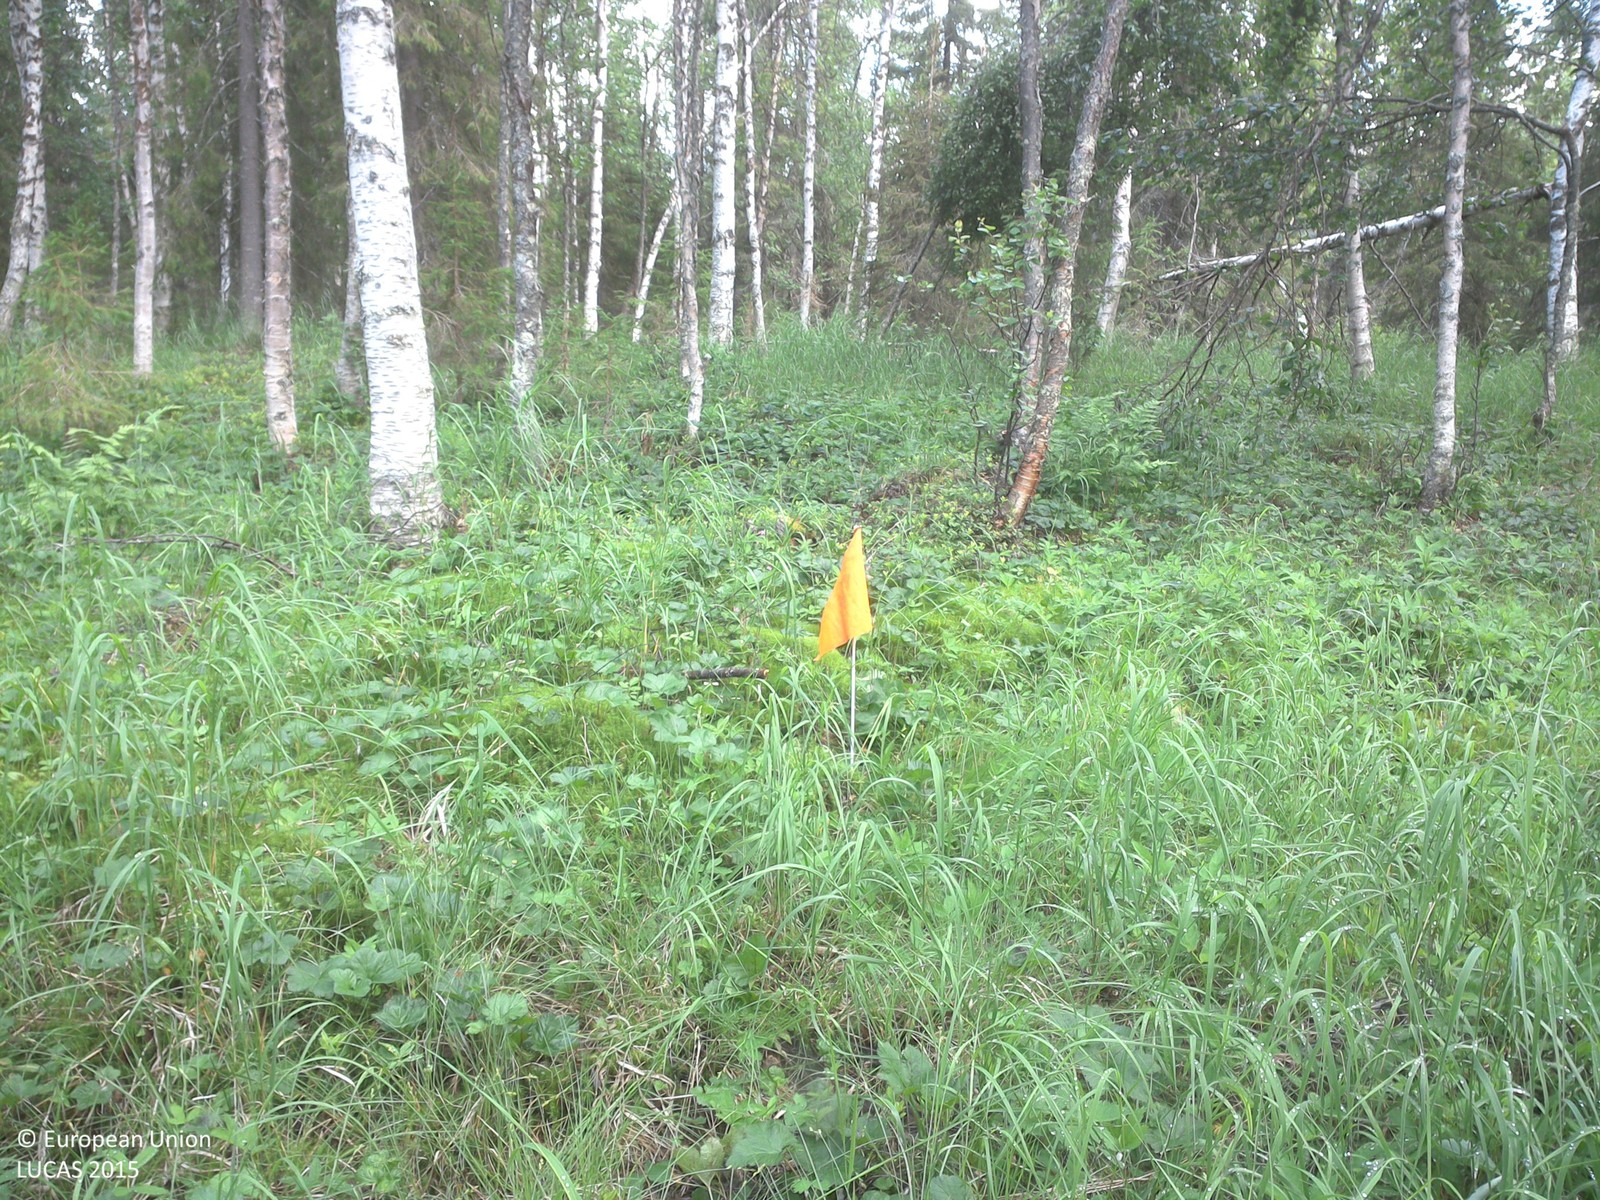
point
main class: Woodland
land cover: Other mixed woodland
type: boreal forest
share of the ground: 25 - 50 %
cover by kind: broadleaved forest trees 30 %, herbaceous plants 30 %, shrubs 15 %, lichens and mosses 15 %, coniferous forest trees 10 %
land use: Forestry
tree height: > 5 m
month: July
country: SE
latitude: 67.6510
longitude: 23.4699
